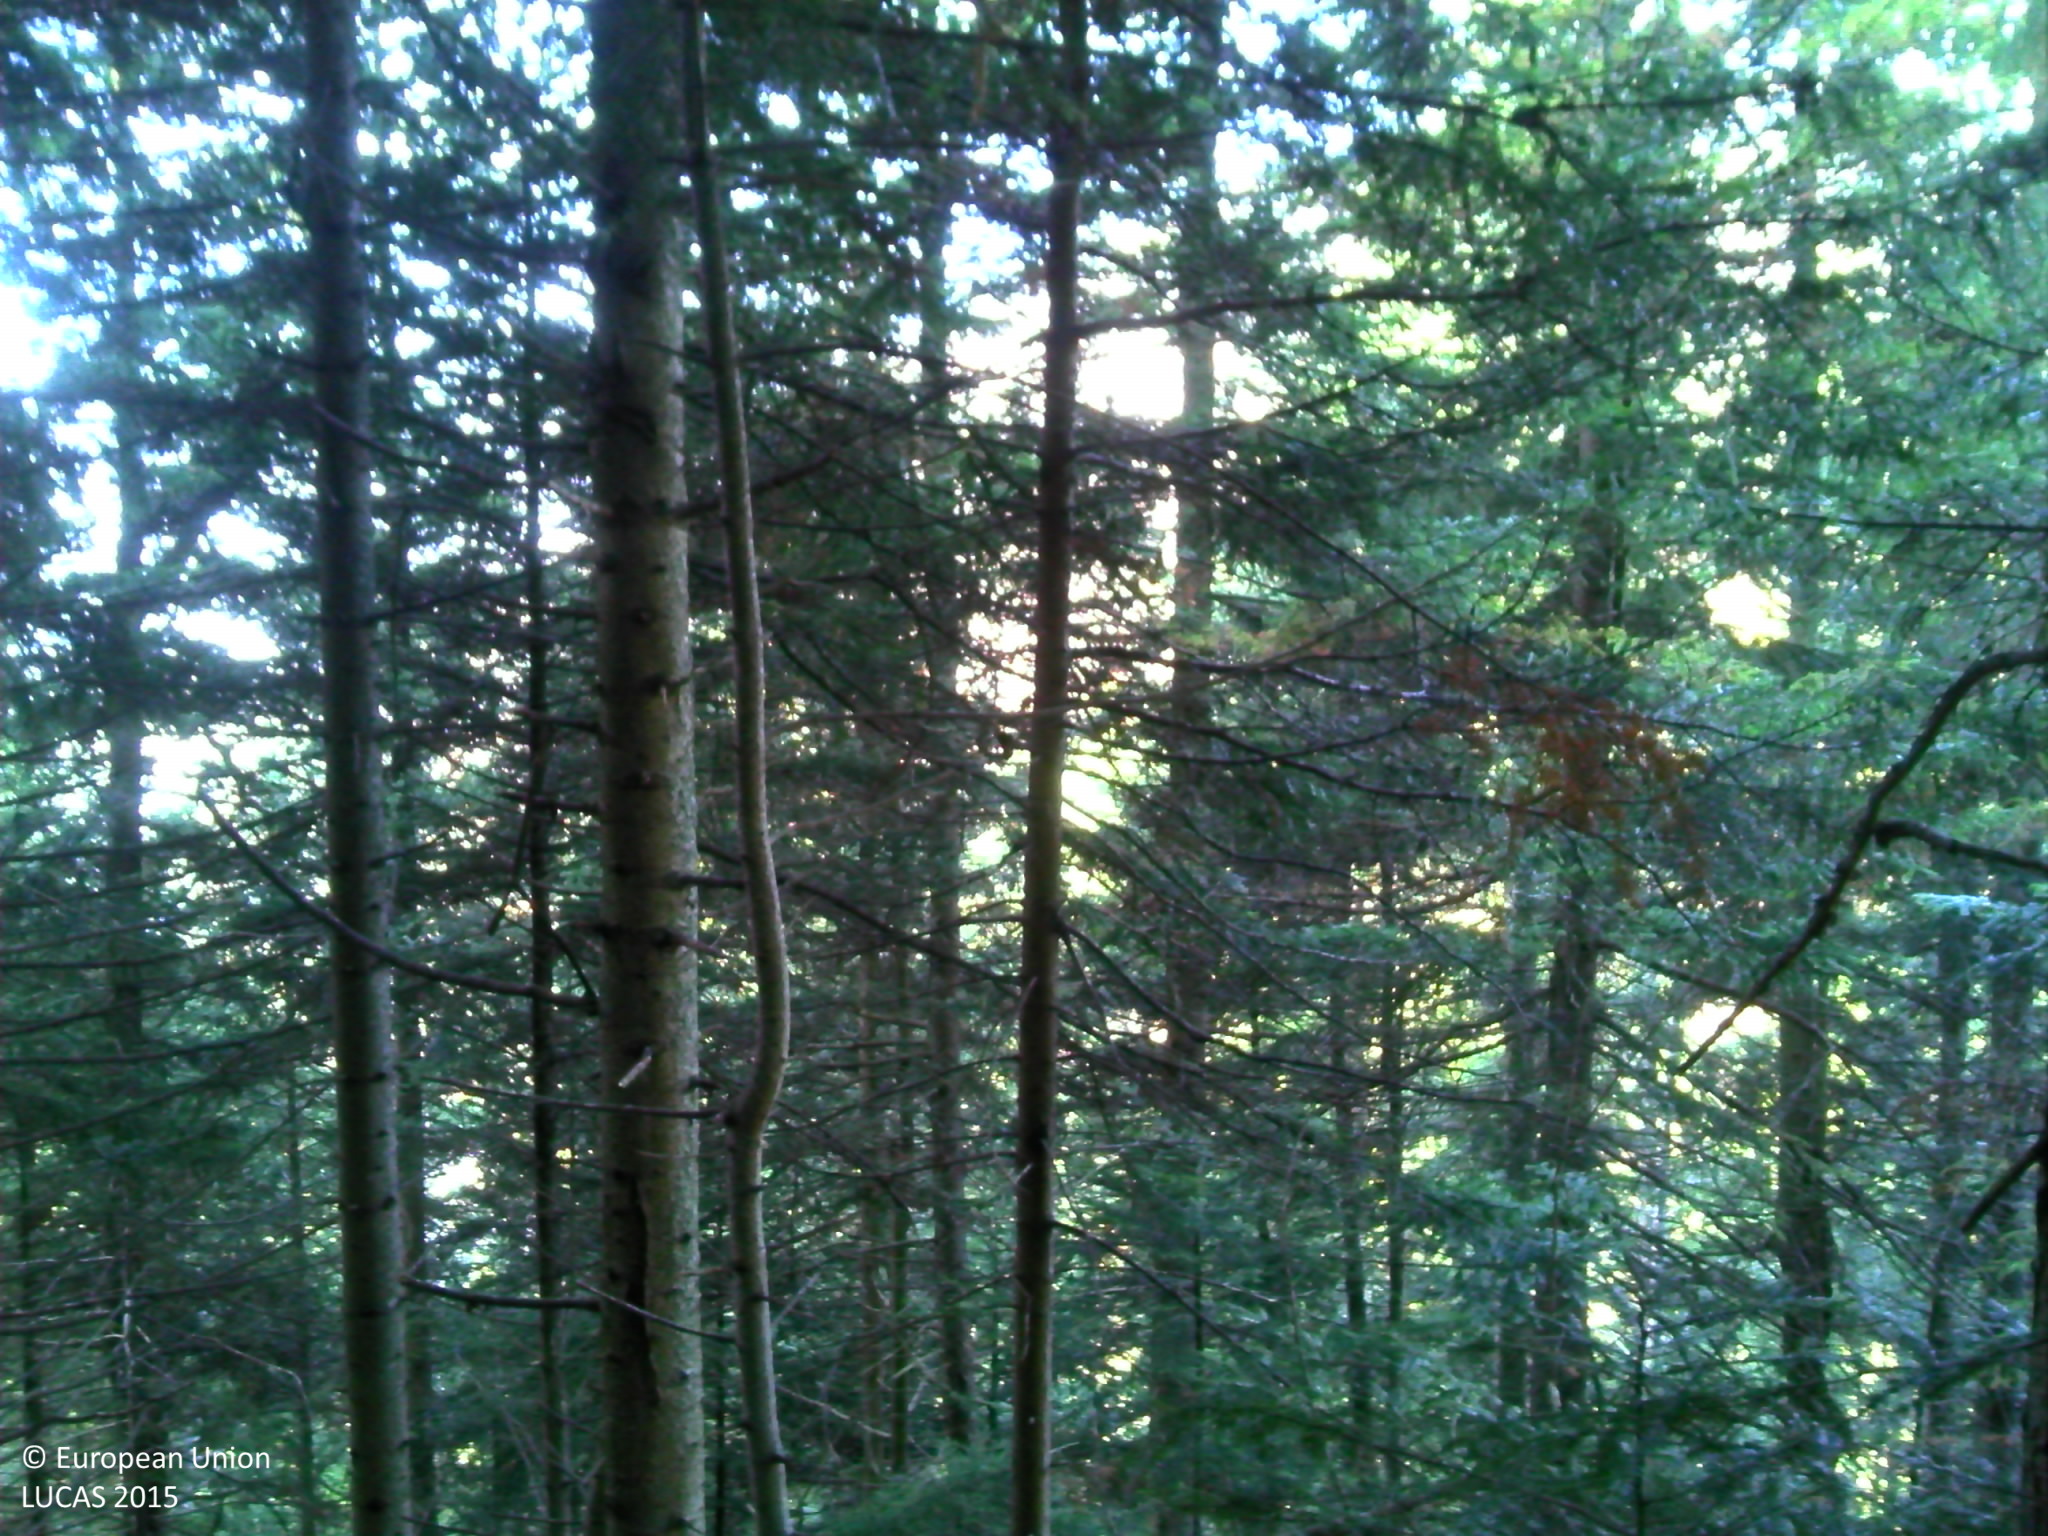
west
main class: Woodland
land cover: Spruce dominated coniferous woodland
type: alpine coniferous forest
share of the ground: > 75 %
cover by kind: coniferous forest trees 95 %, consolidated bare surface 5 %
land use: Forestry
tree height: > 5 m
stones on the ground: < 10 %
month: October
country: FR
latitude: 45.3337
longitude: 6.3683
